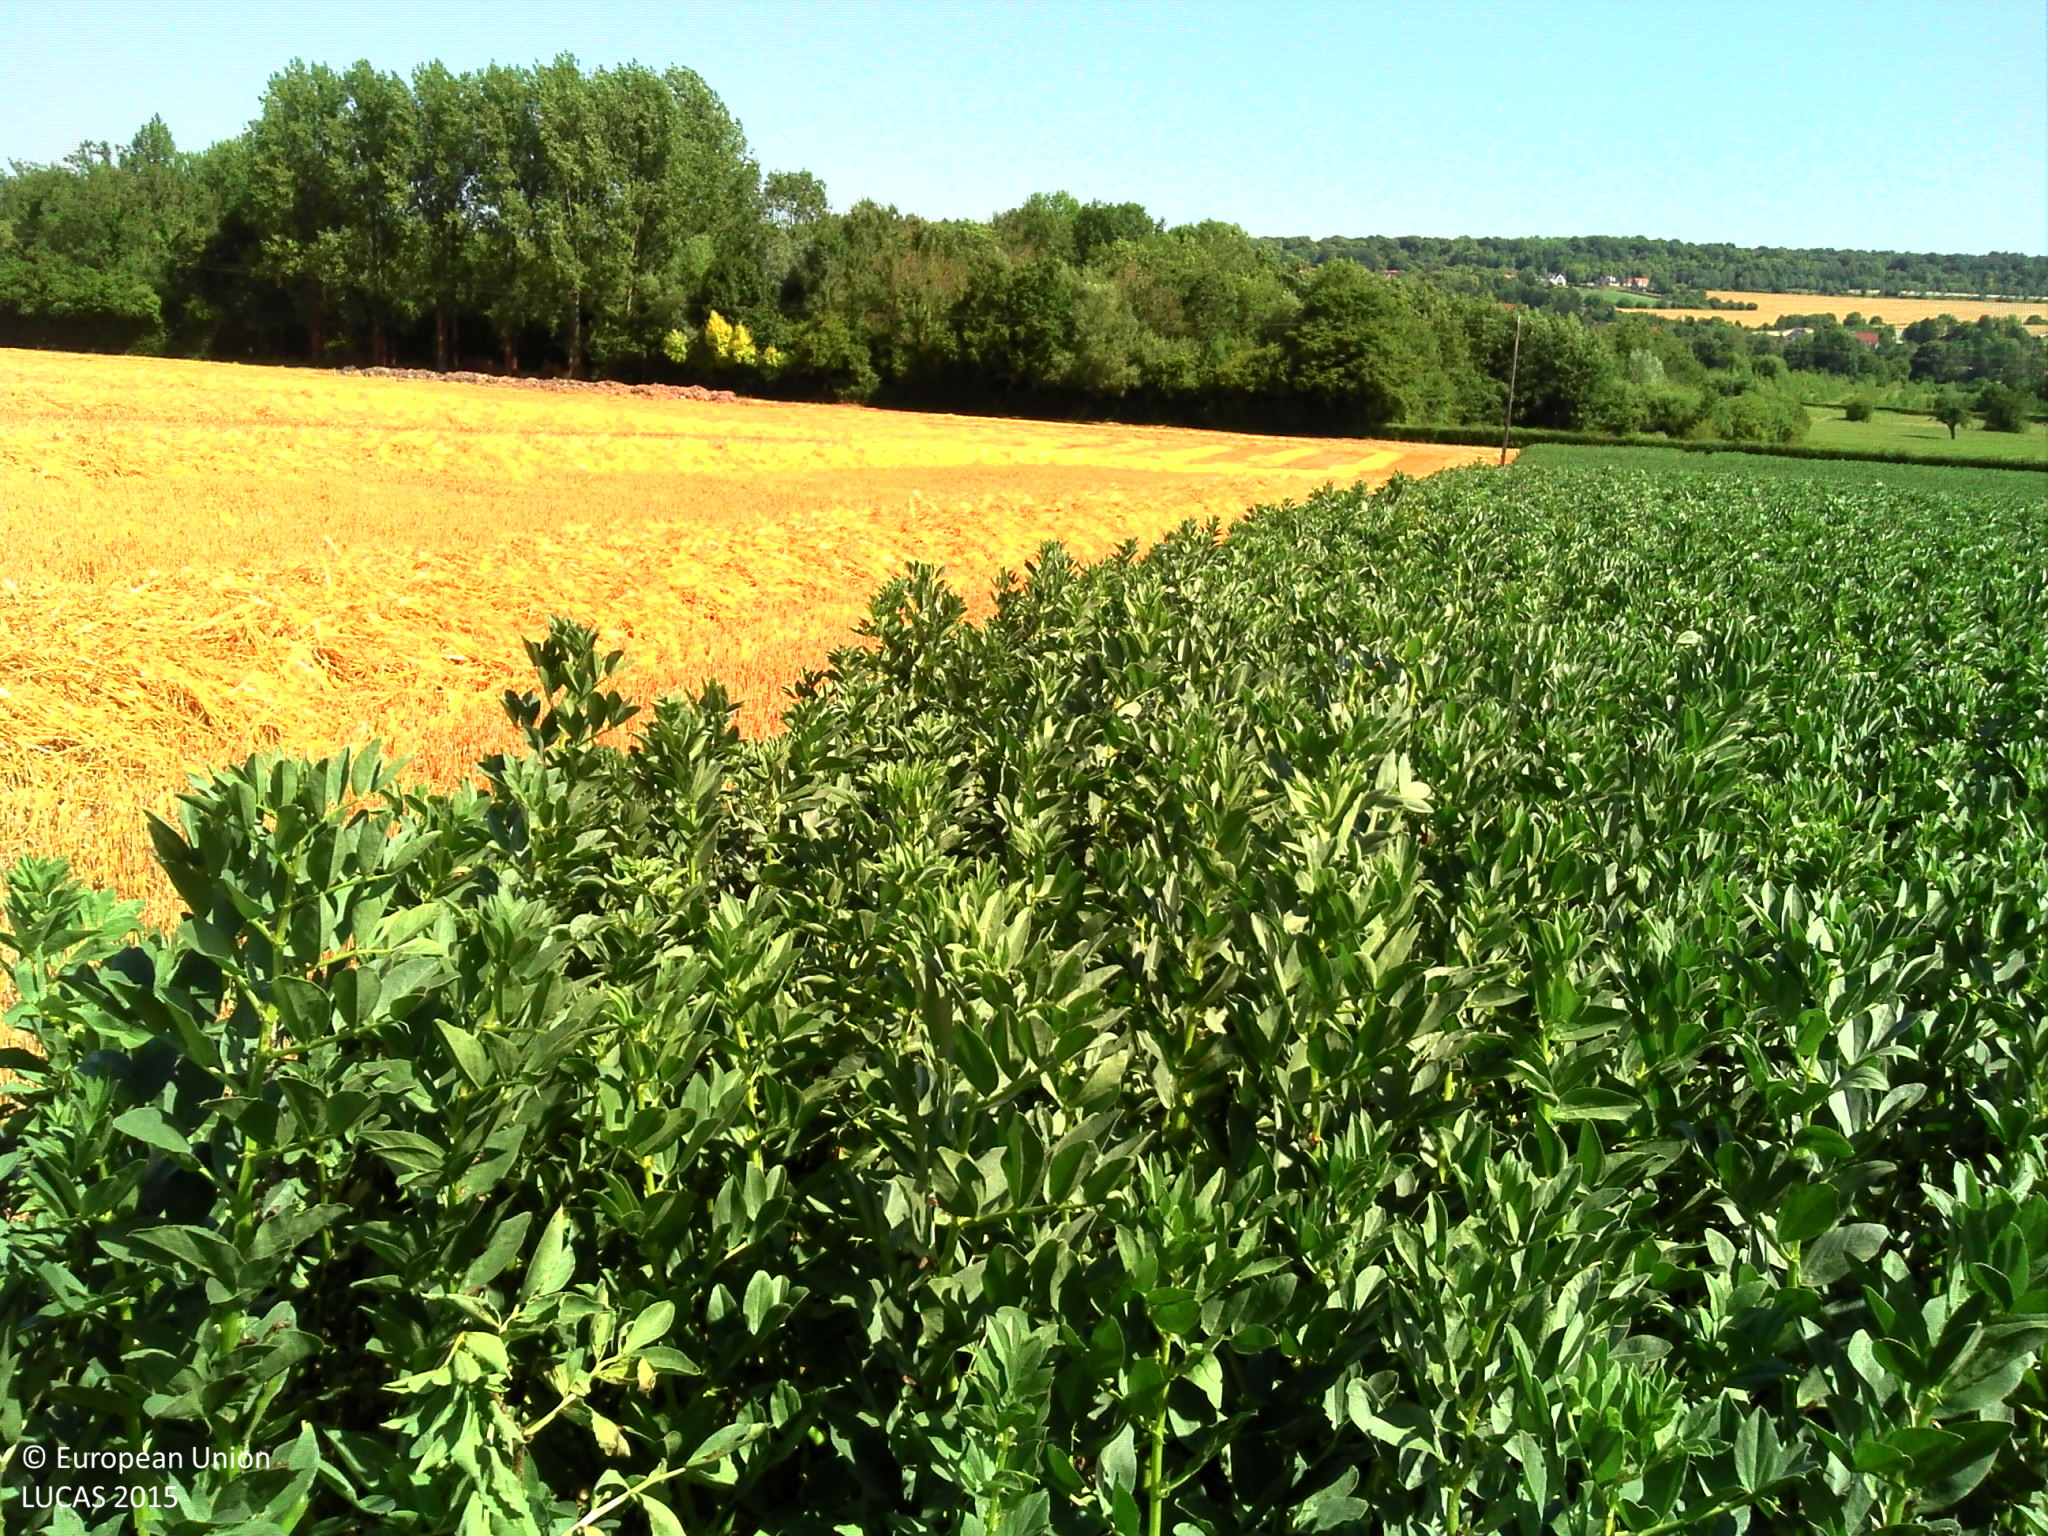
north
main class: Cropland
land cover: Dry pulses
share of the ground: > 75 %
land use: Agriculture (excluding fallow land and kitchen gardens)
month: July
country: FR
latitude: 50.2186
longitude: 2.1228
